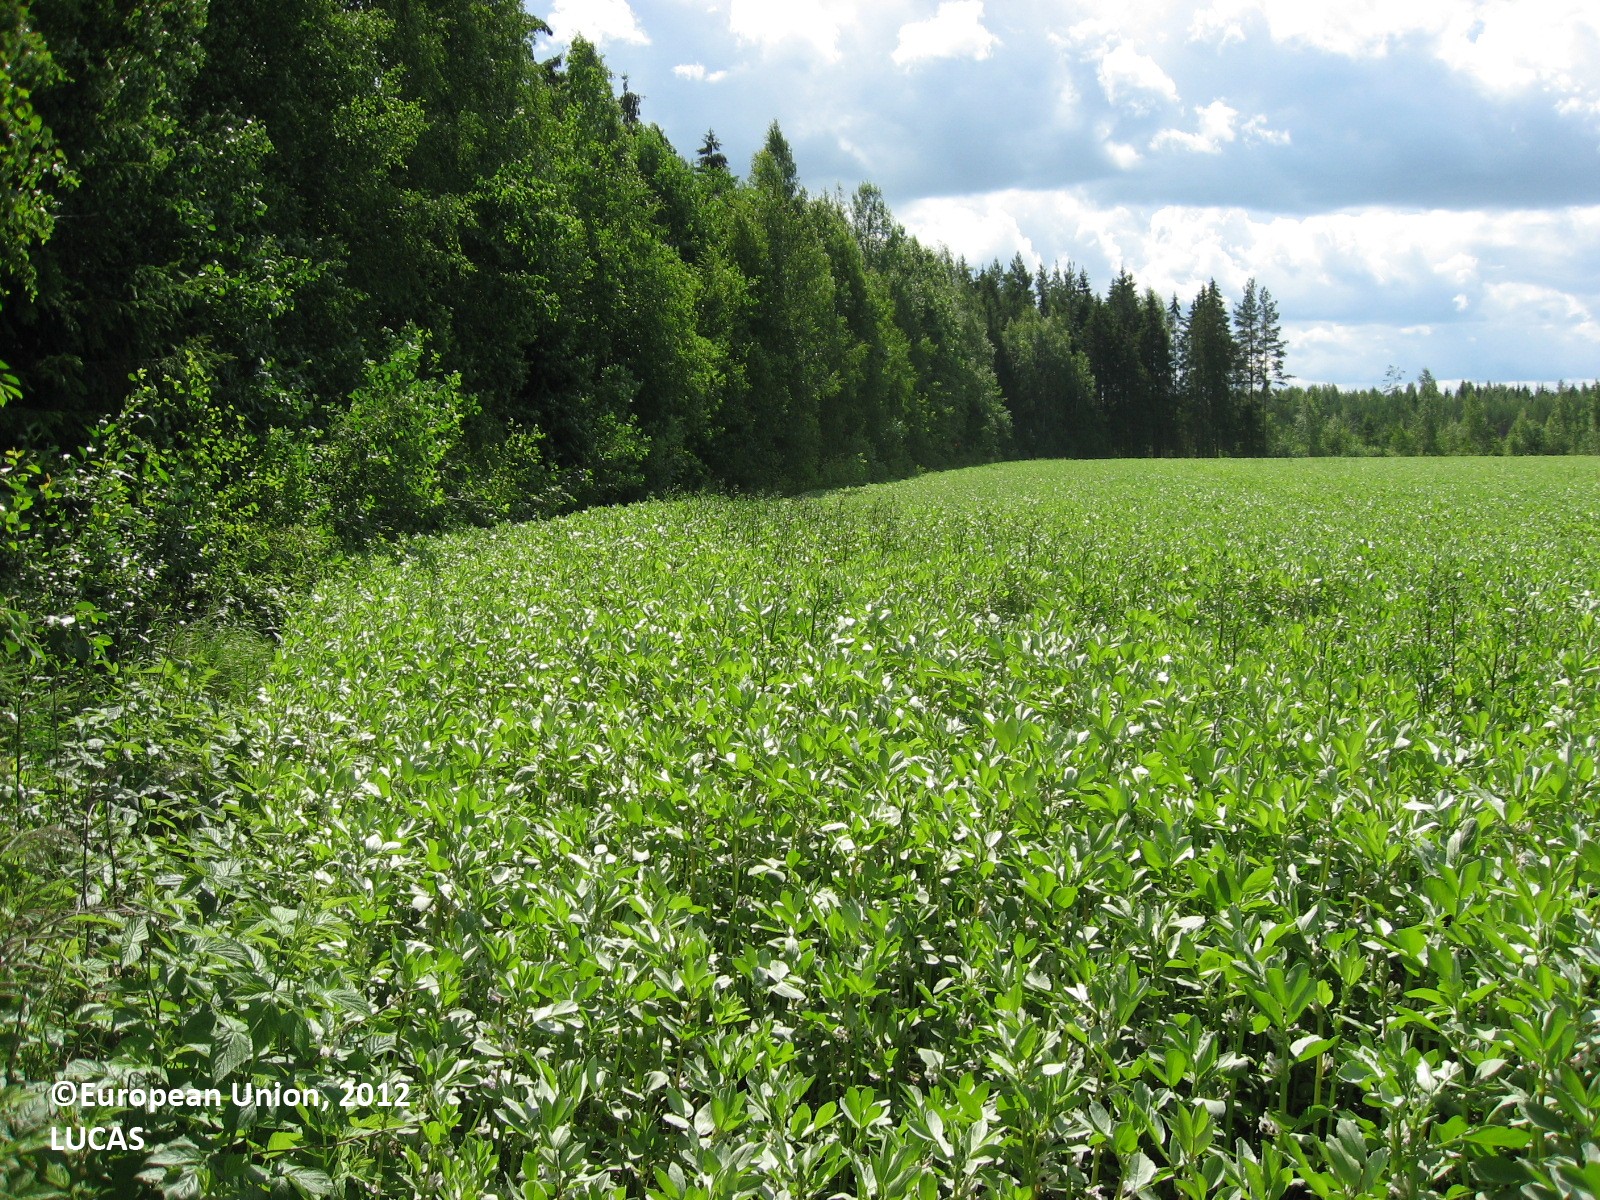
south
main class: Cropland
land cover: Dry pulses
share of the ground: > 75 %
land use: Agriculture (excluding fallow land and kitchen gardens)
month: July
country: FI
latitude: 60.7431
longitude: 26.2334
